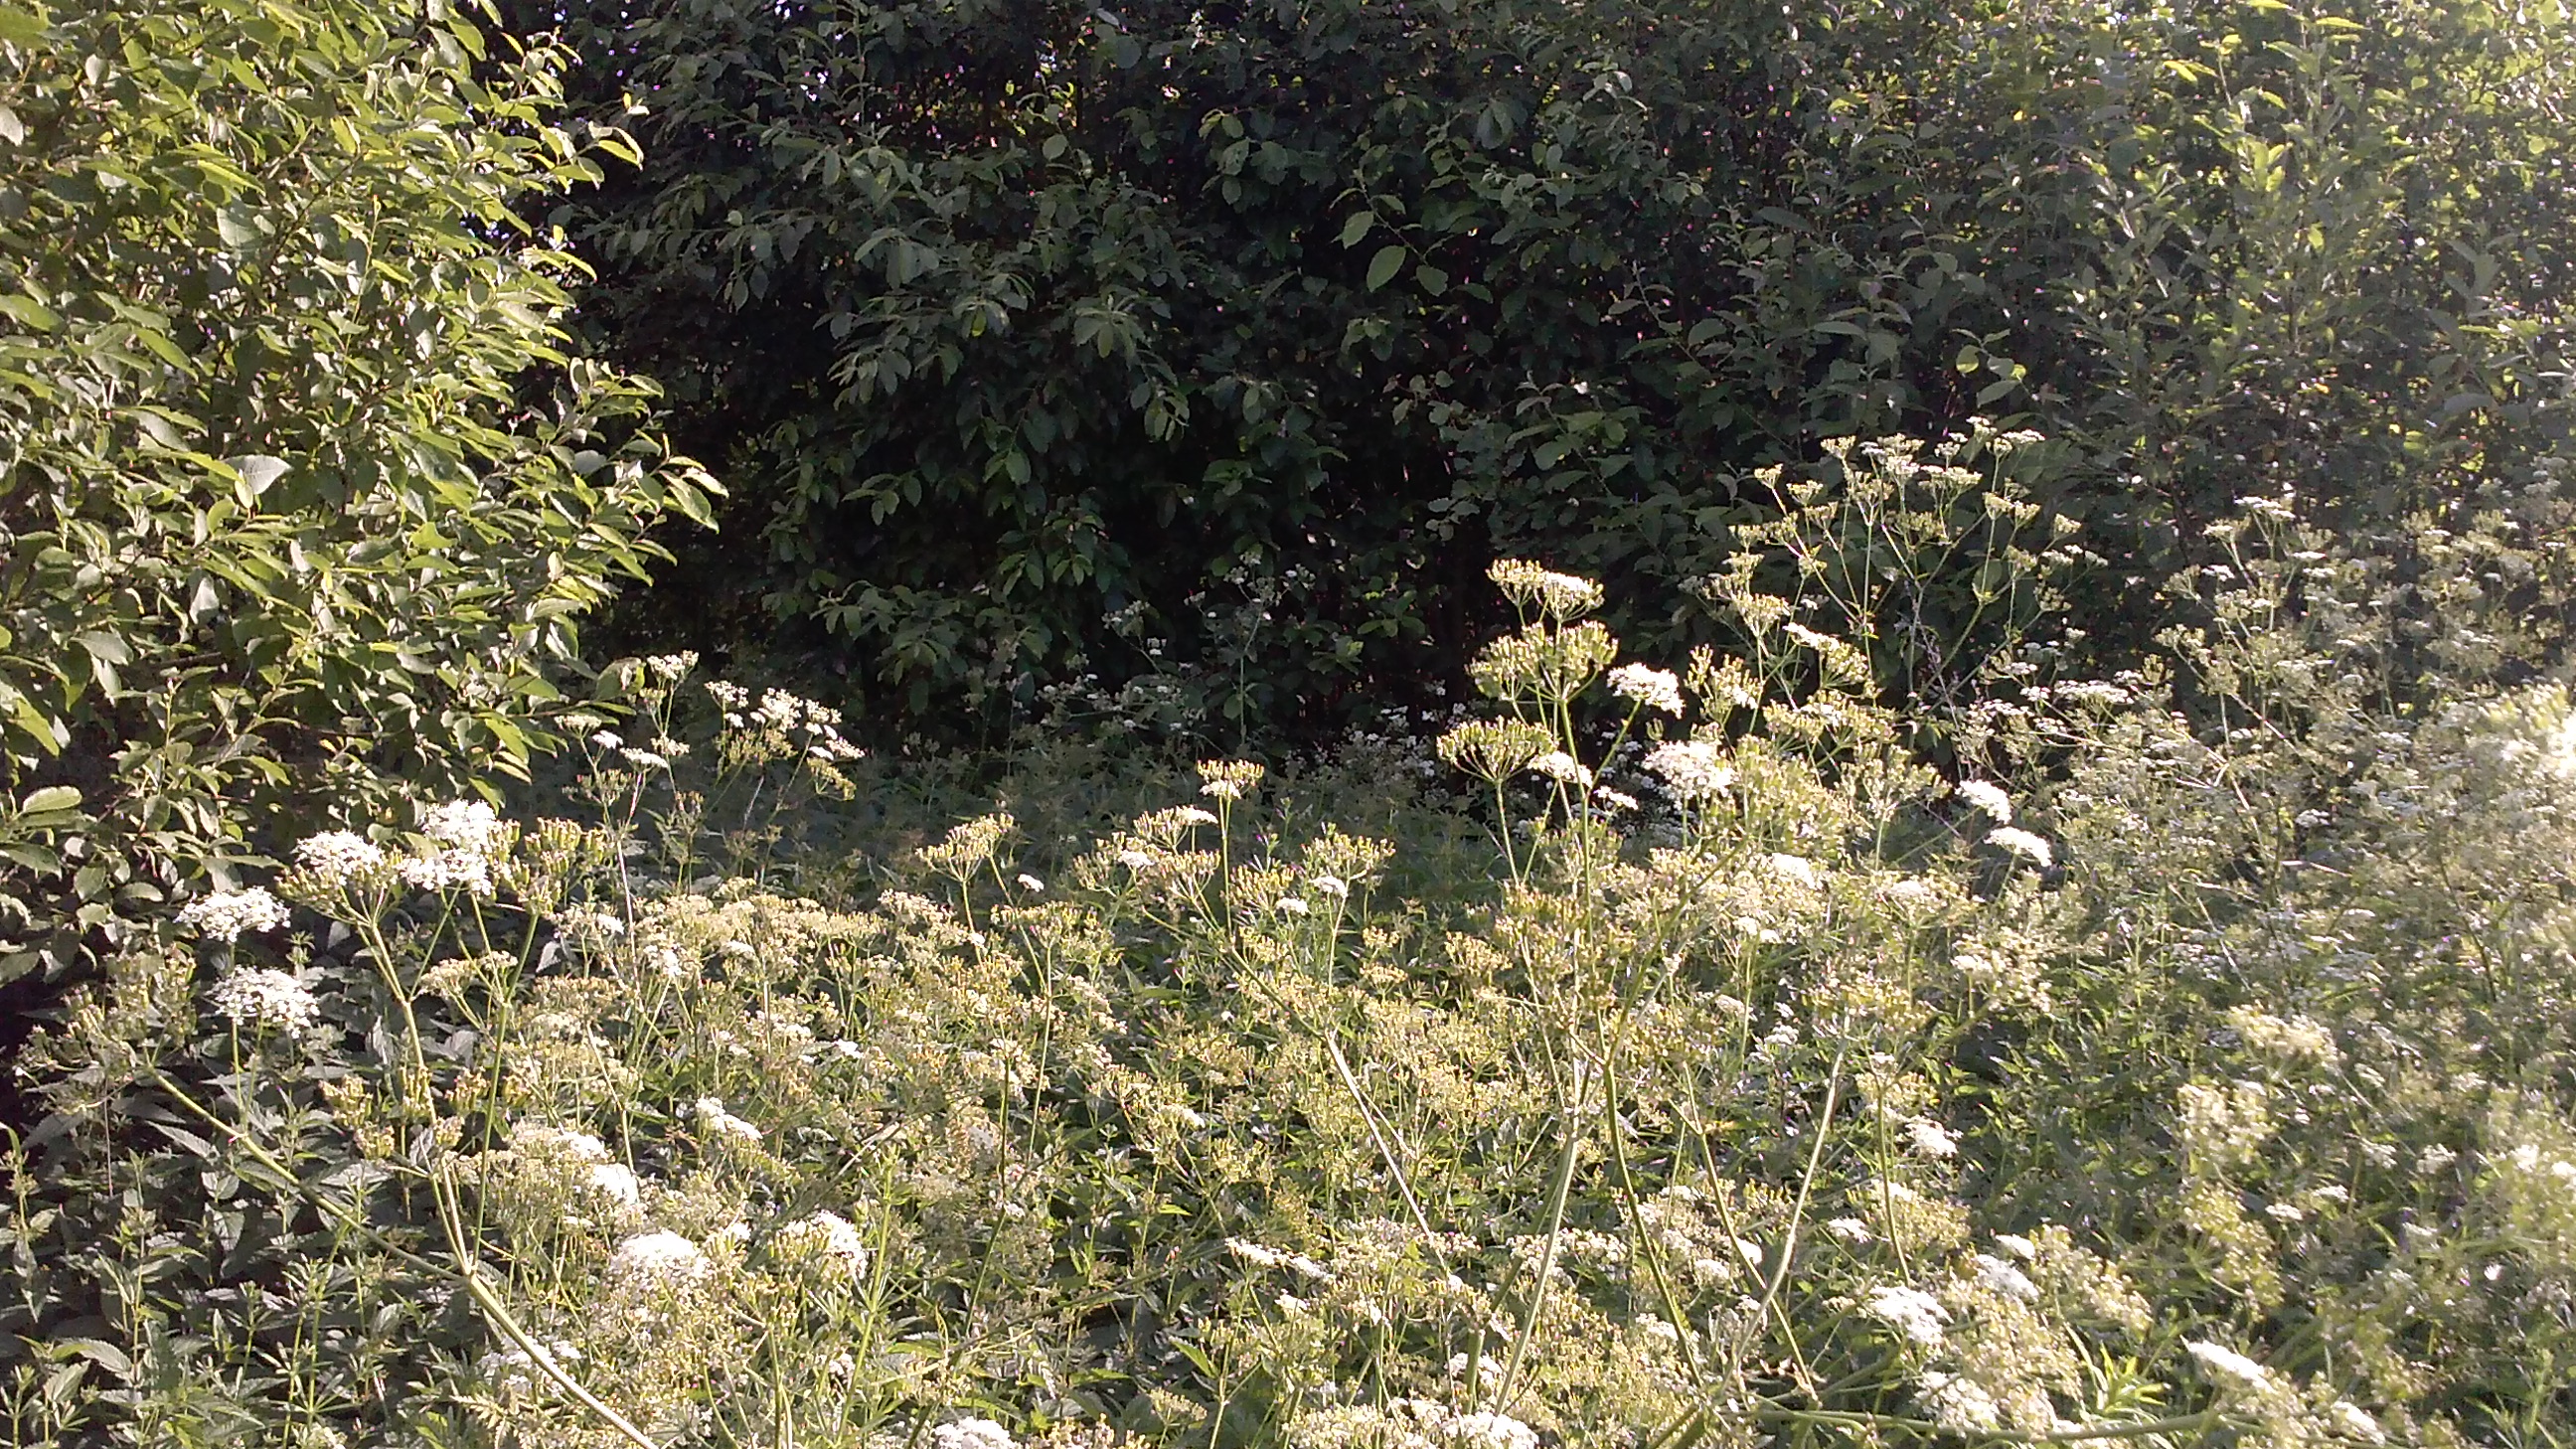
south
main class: Grassland
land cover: Spontaneously vegetated surfaces
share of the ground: > 75 %
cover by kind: herbaceous plants 100 %
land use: Semi-natural and natural areas not in use
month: June
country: LV
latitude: 56.5300
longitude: 27.9653
